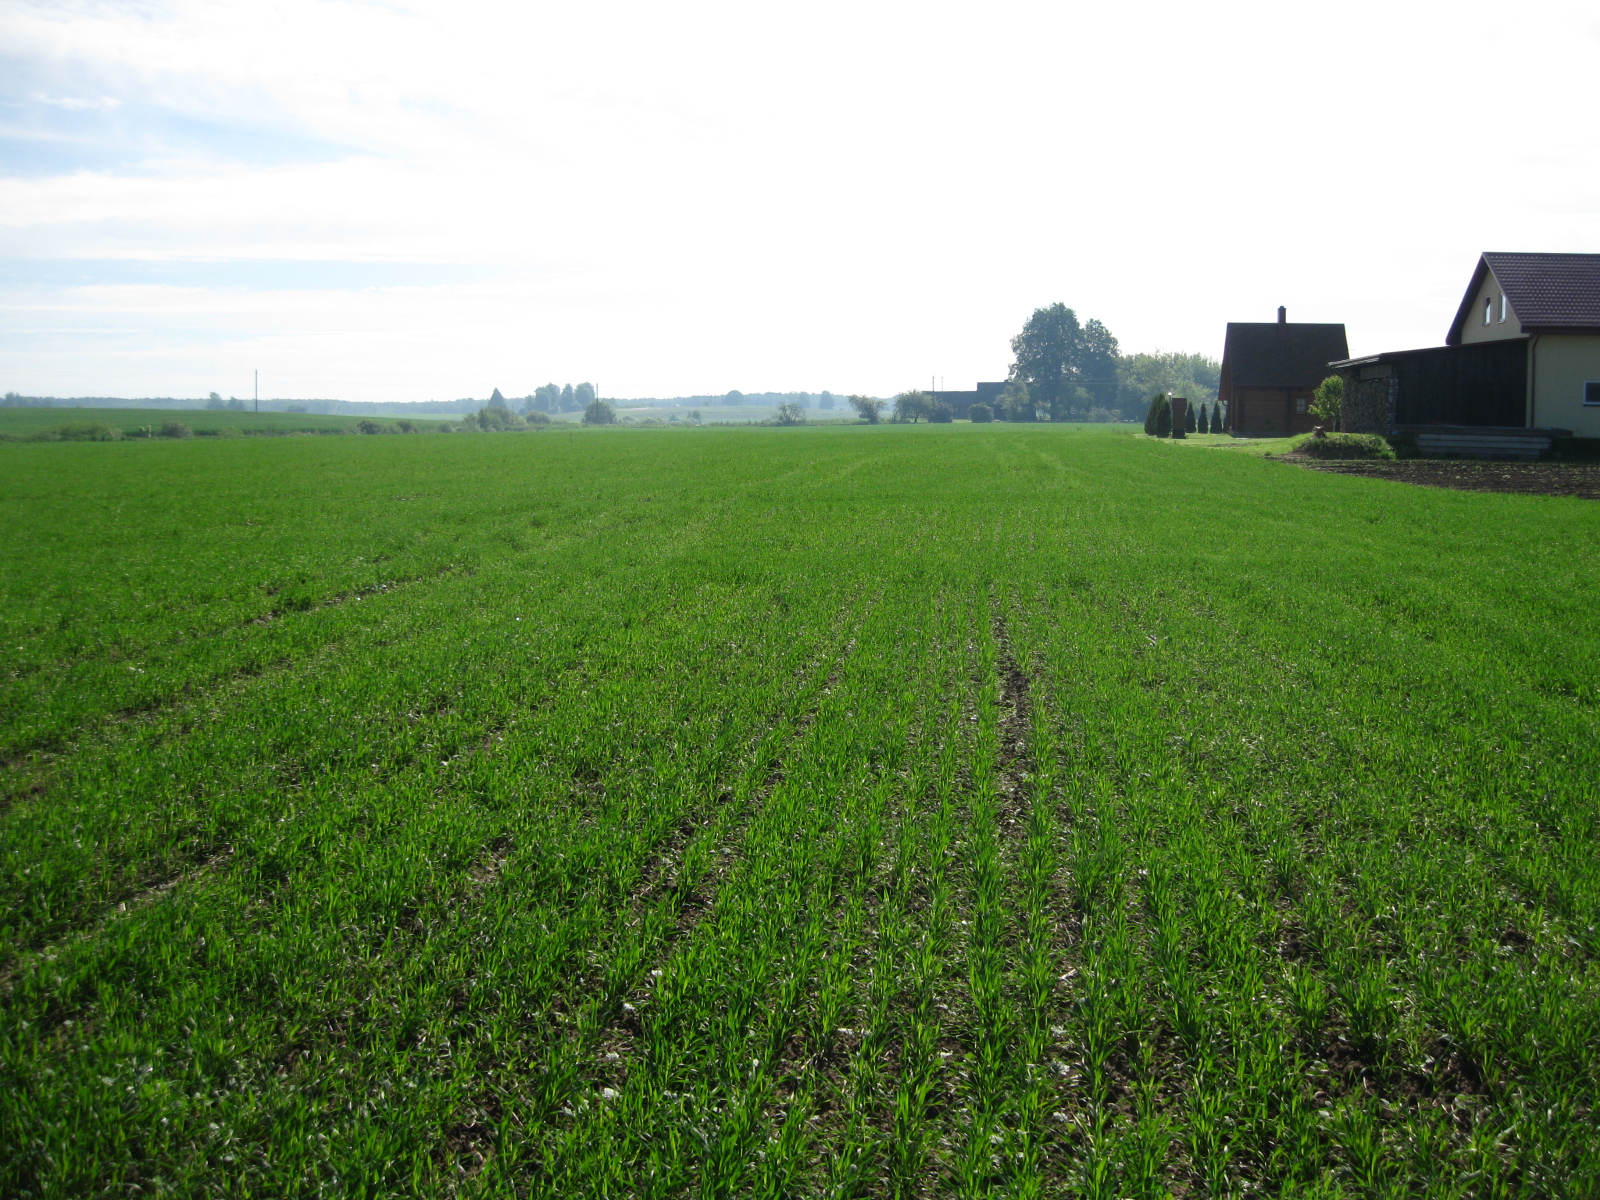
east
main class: Cropland
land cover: Common wheat
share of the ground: 50 - 75 %
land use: Agriculture (excluding fallow land and kitchen gardens)
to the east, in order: Common wheat; Tracks; Grassland without tree/shrub cover
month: May
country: LT
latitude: 55.8499
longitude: 24.3593
